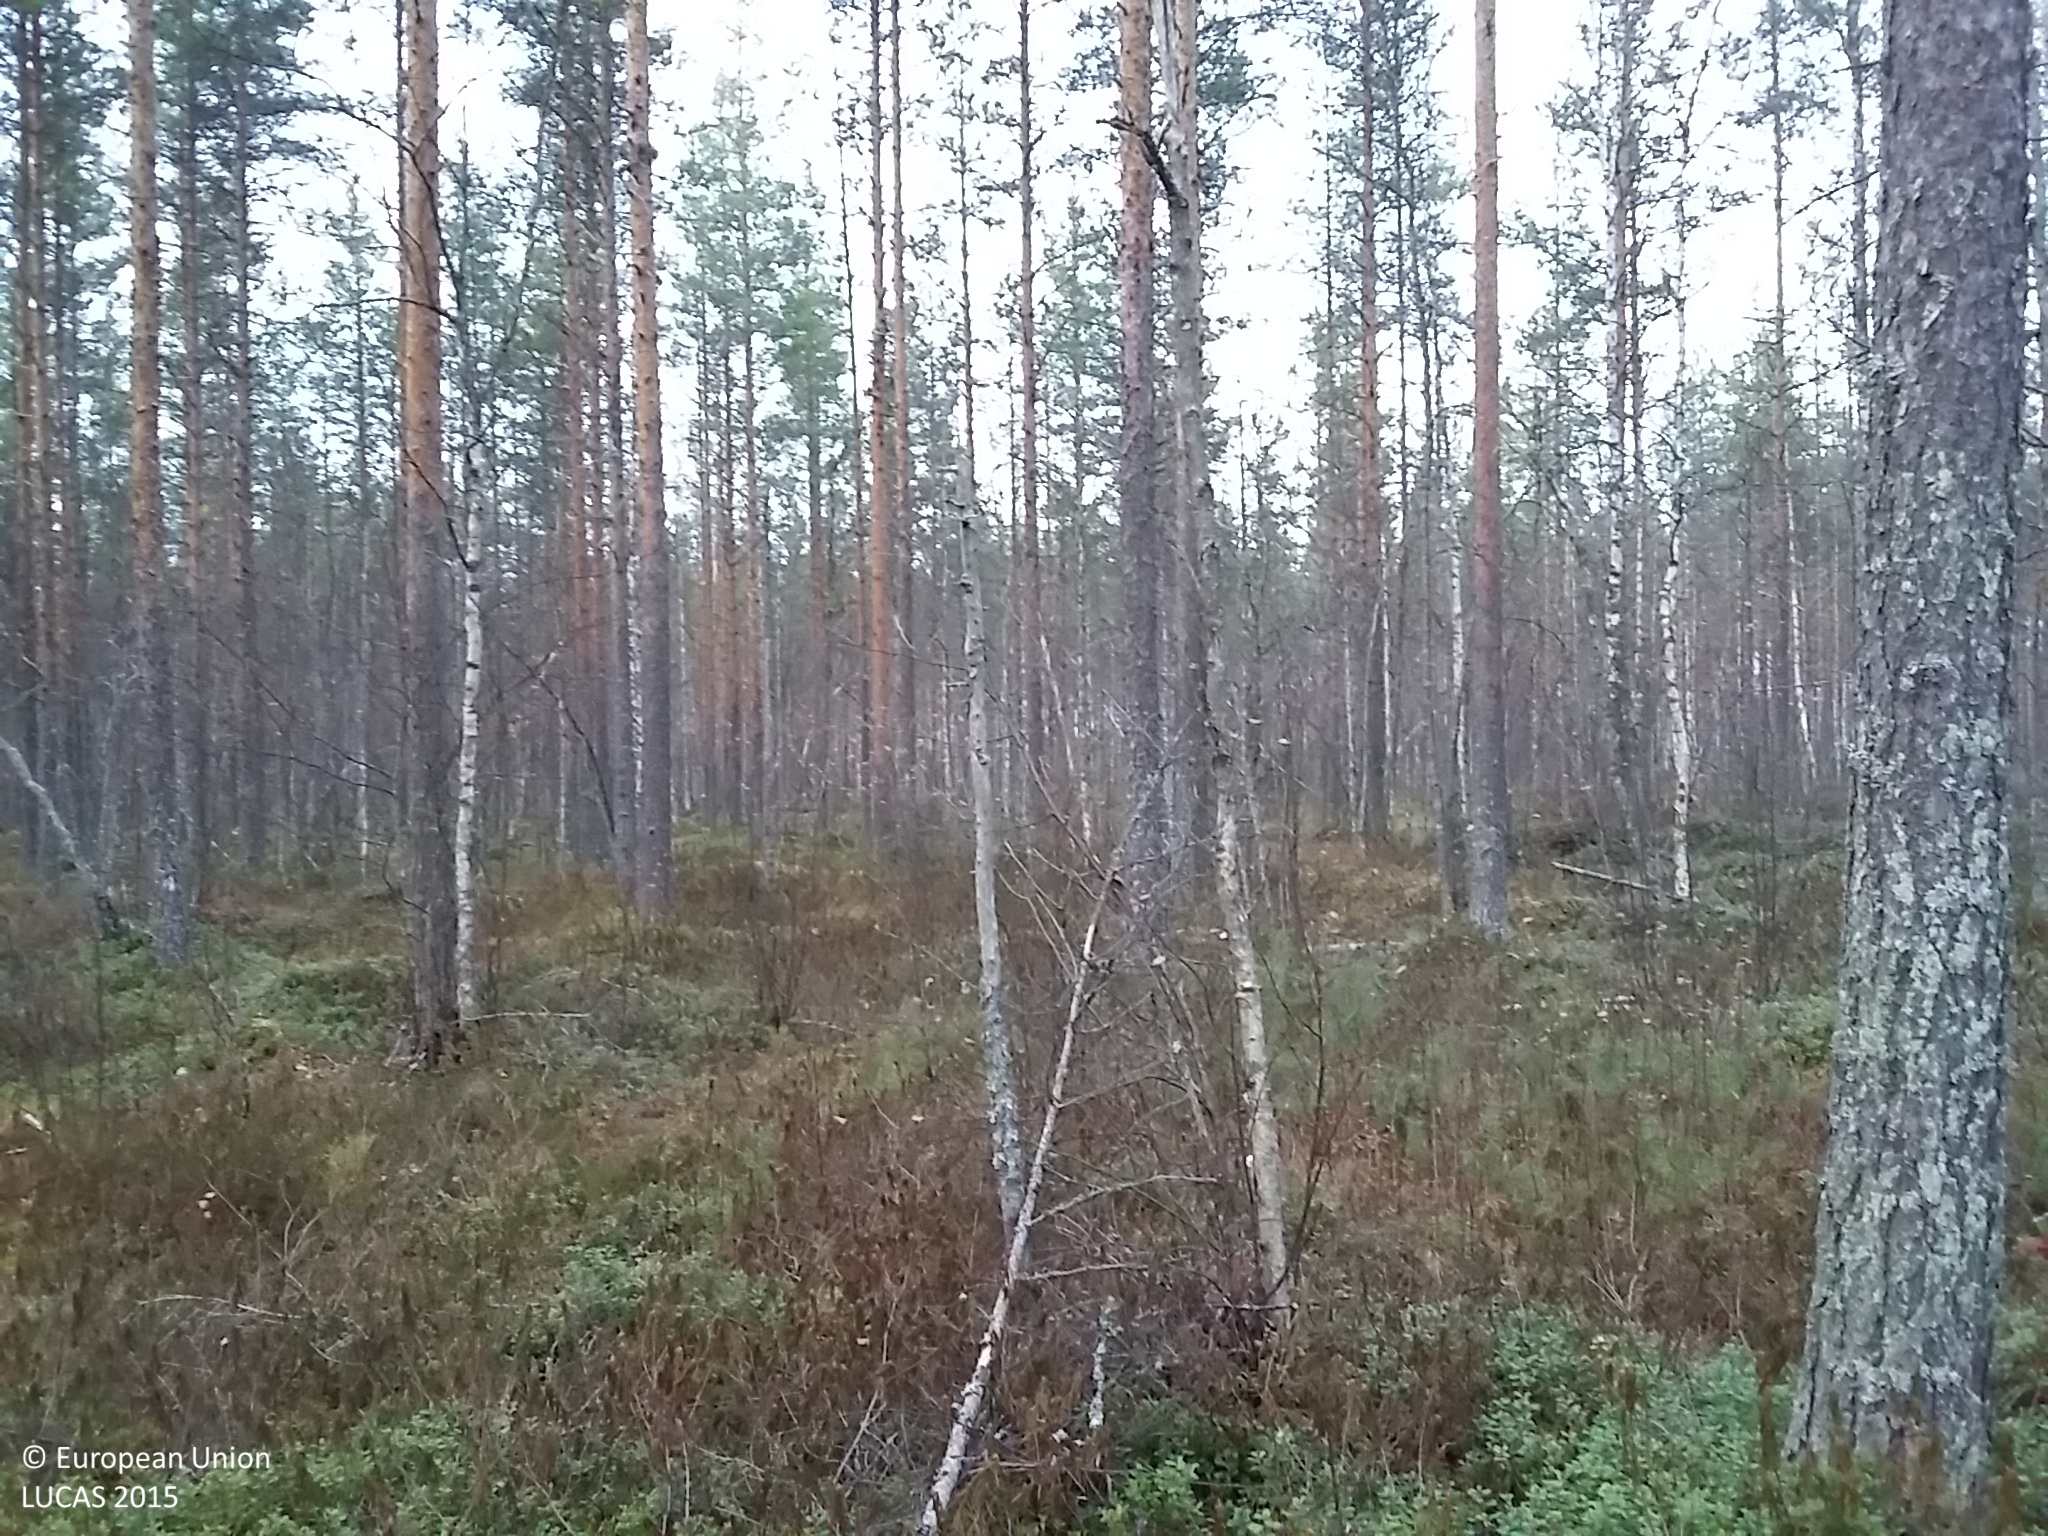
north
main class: Woodland
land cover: Pine dominated coniferous woodland
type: boreal forest
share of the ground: > 75 %
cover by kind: coniferous forest trees 75 %, shrubs 10 %, lichens and mosses 10 %, herbaceous plants 5 %
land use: Forestry
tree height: > 5 m
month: October
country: FI
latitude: 64.0647
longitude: 25.0241
